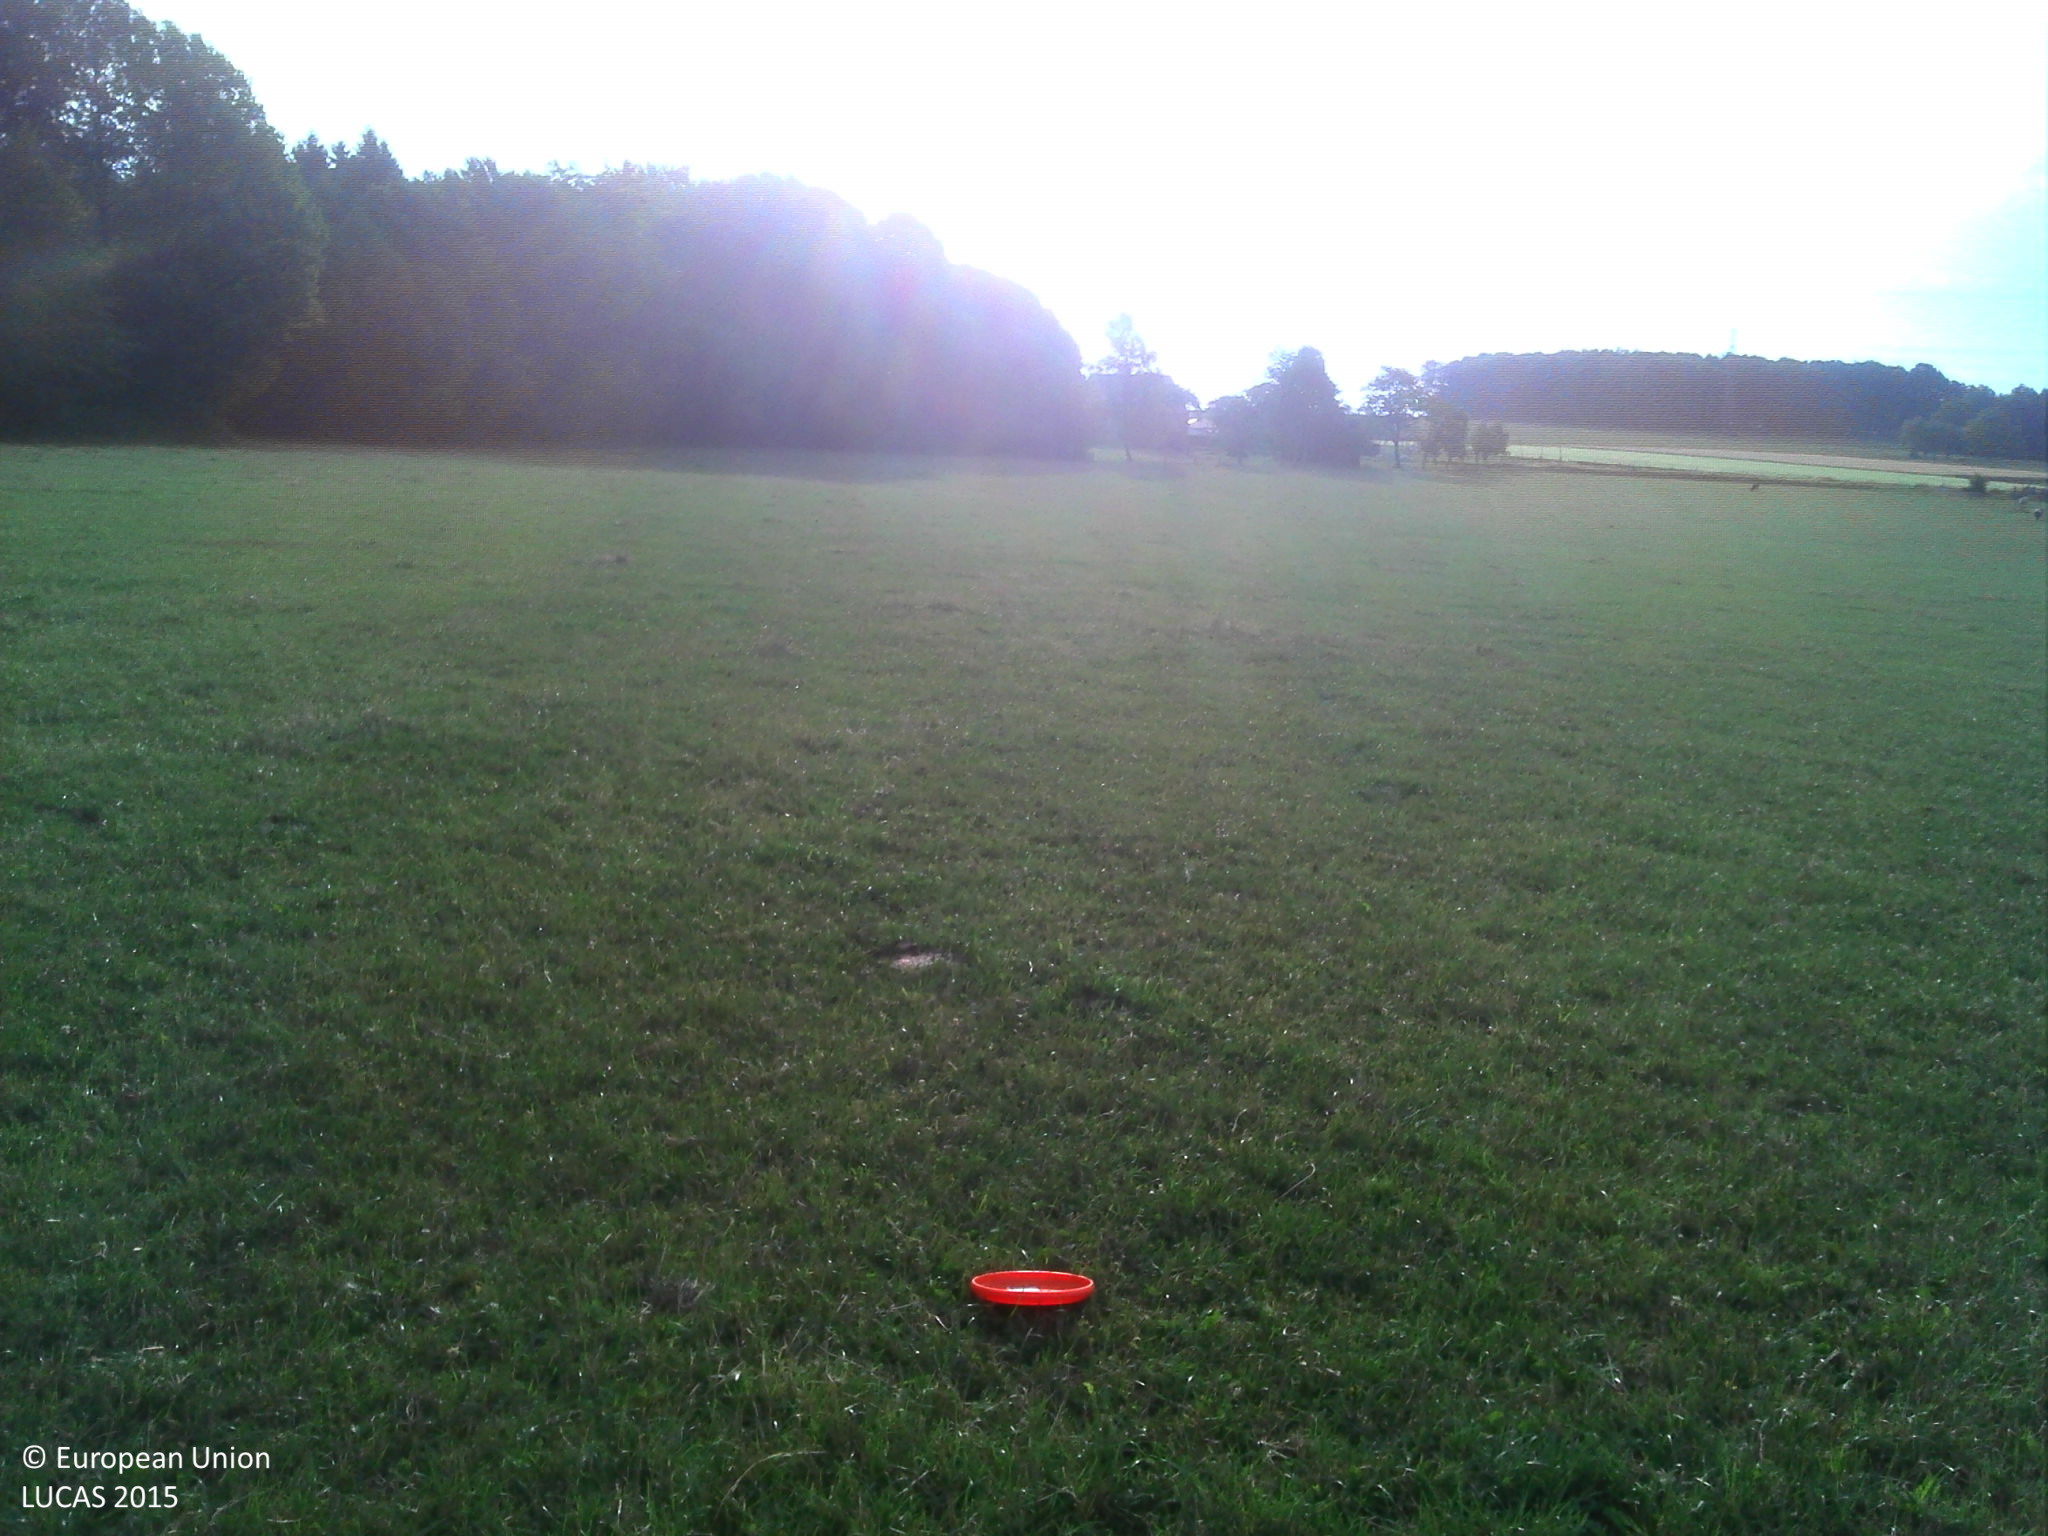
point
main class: Grassland
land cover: Grassland without tree/shrub cover
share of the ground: > 75 %
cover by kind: herbaceous plants 100 %
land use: Agriculture (excluding fallow land and kitchen gardens)
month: July
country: BE
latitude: 49.9398
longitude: 5.6653
